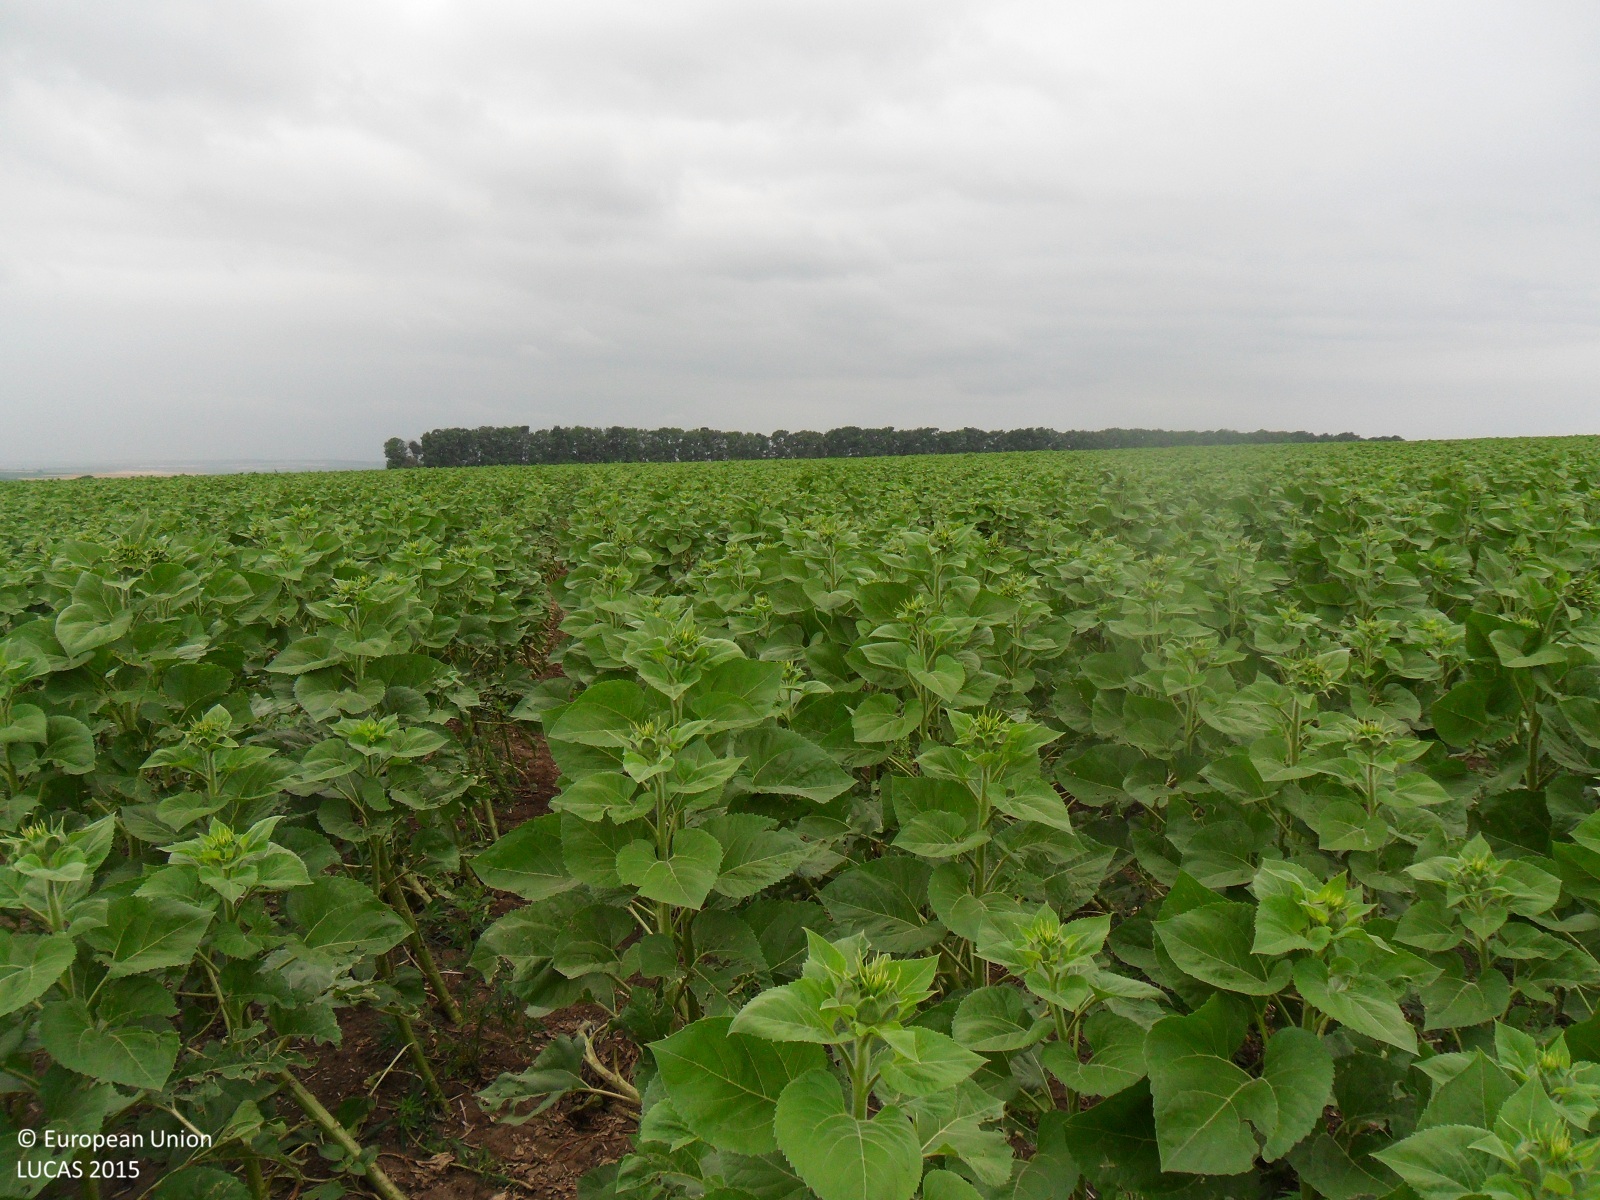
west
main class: Cropland
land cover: Sunflower
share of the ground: > 75 %
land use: Agriculture (excluding fallow land and kitchen gardens)
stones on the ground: < 10 %
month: June
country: BG
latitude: 43.8130
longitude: 26.8122
